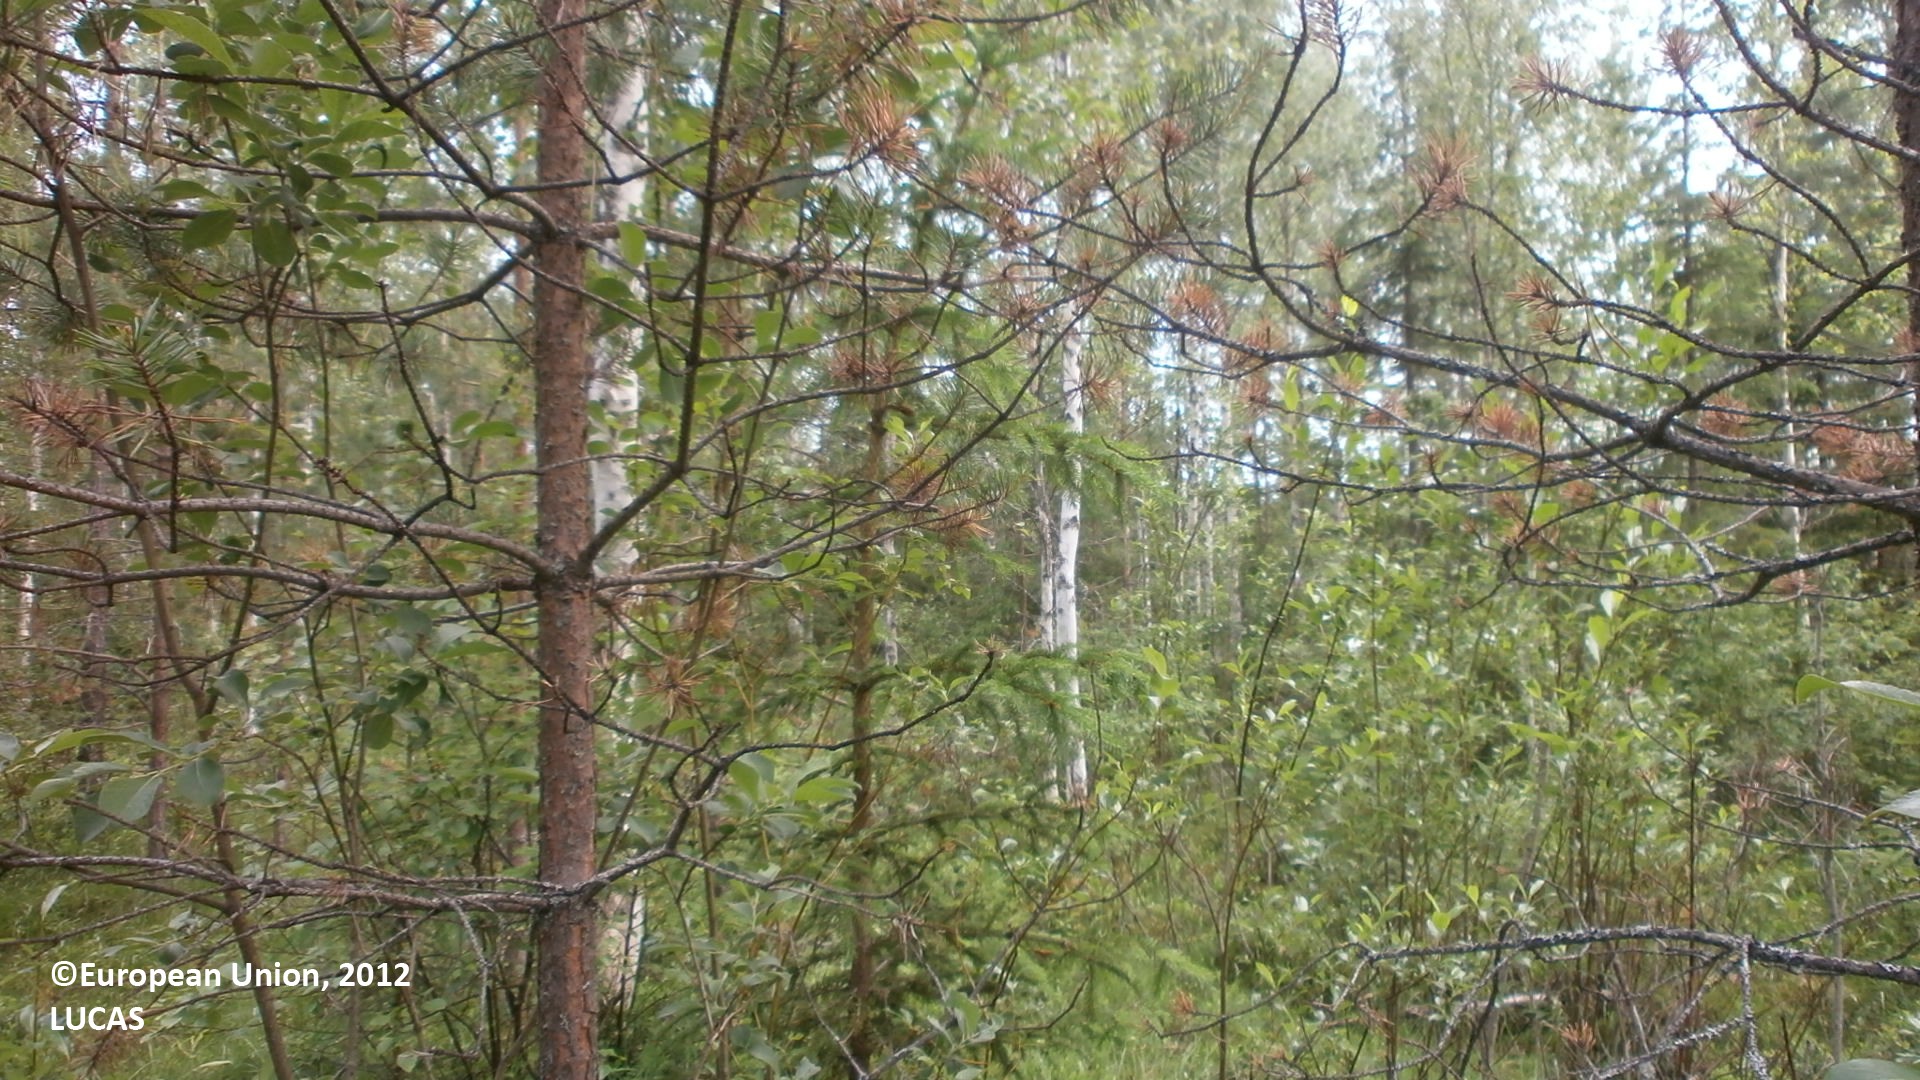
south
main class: Woodland
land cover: Pine dominated mixed woodland
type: boreal forest
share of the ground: 50 - 75 %
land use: Forestry
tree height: > 5 m
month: July
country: FI
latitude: 64.2281
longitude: 24.8595
